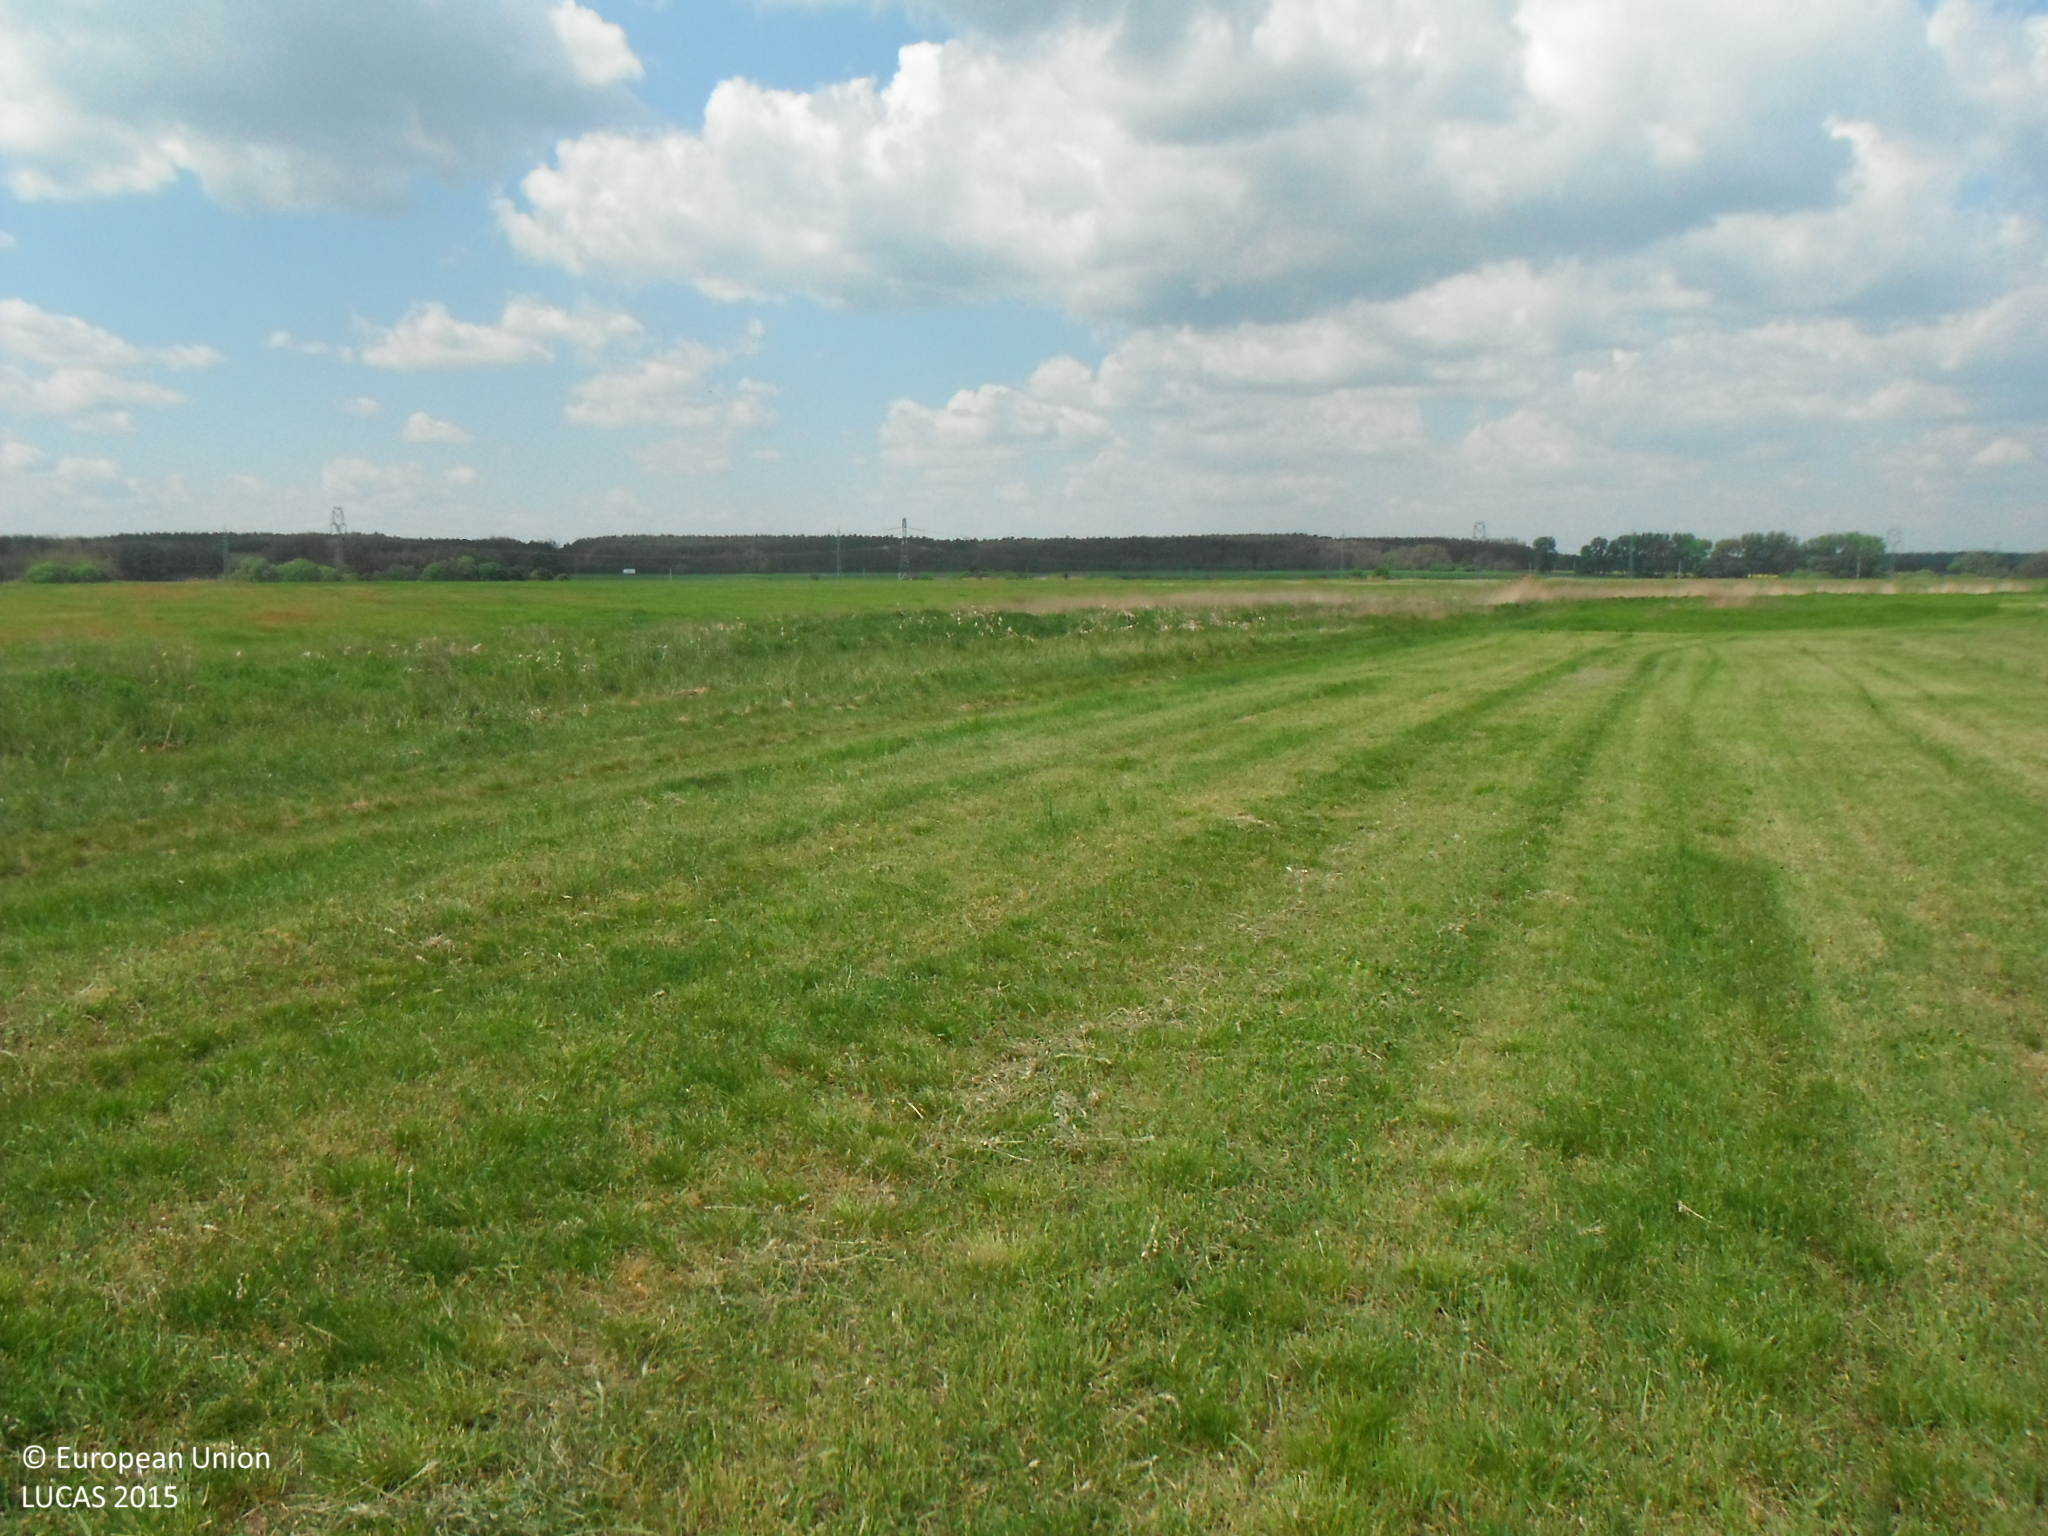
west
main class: Grassland
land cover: Grassland without tree/shrub cover
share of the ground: > 75 %
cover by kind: herbaceous plants 100 %
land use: Agriculture (excluding fallow land and kitchen gardens)
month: May
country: SK
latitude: 48.5582
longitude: 17.0405
